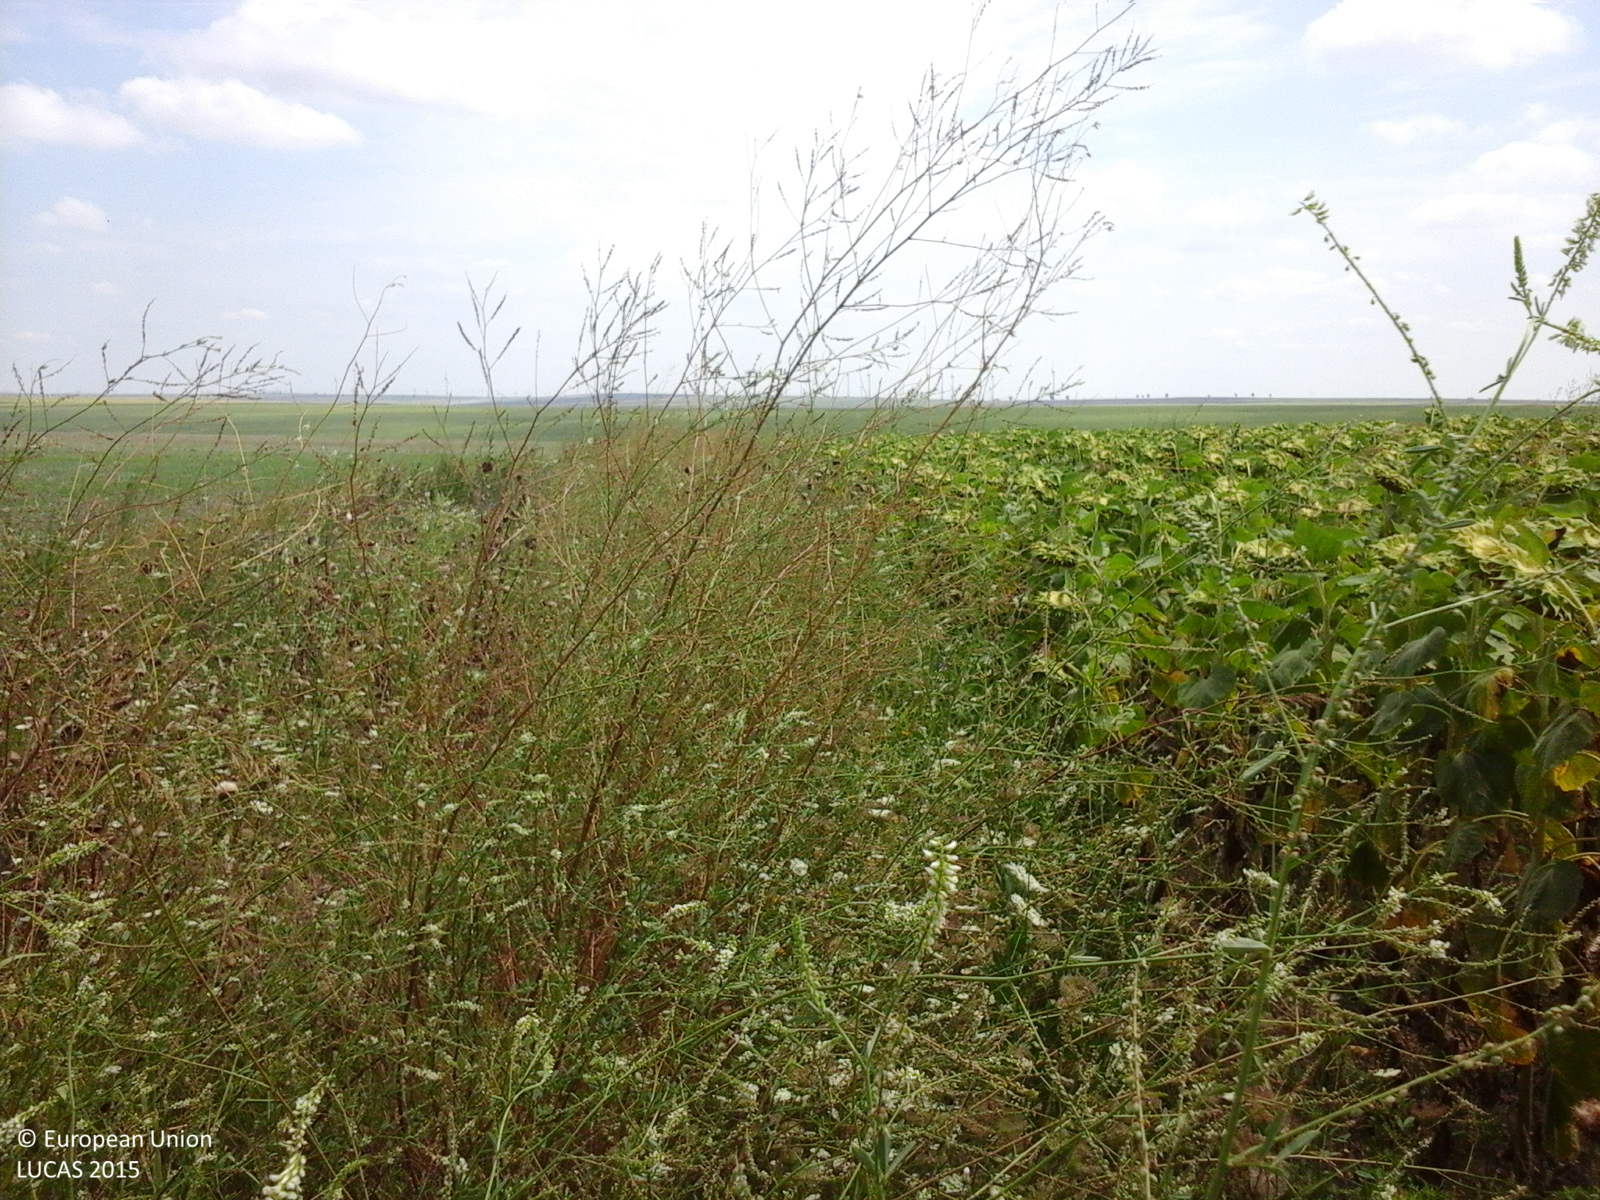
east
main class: Cropland
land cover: Sunflower
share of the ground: > 75 %
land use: Agriculture (excluding fallow land and kitchen gardens)
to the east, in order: Sunflower
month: August
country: RO
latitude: 44.7815
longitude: 28.1496
